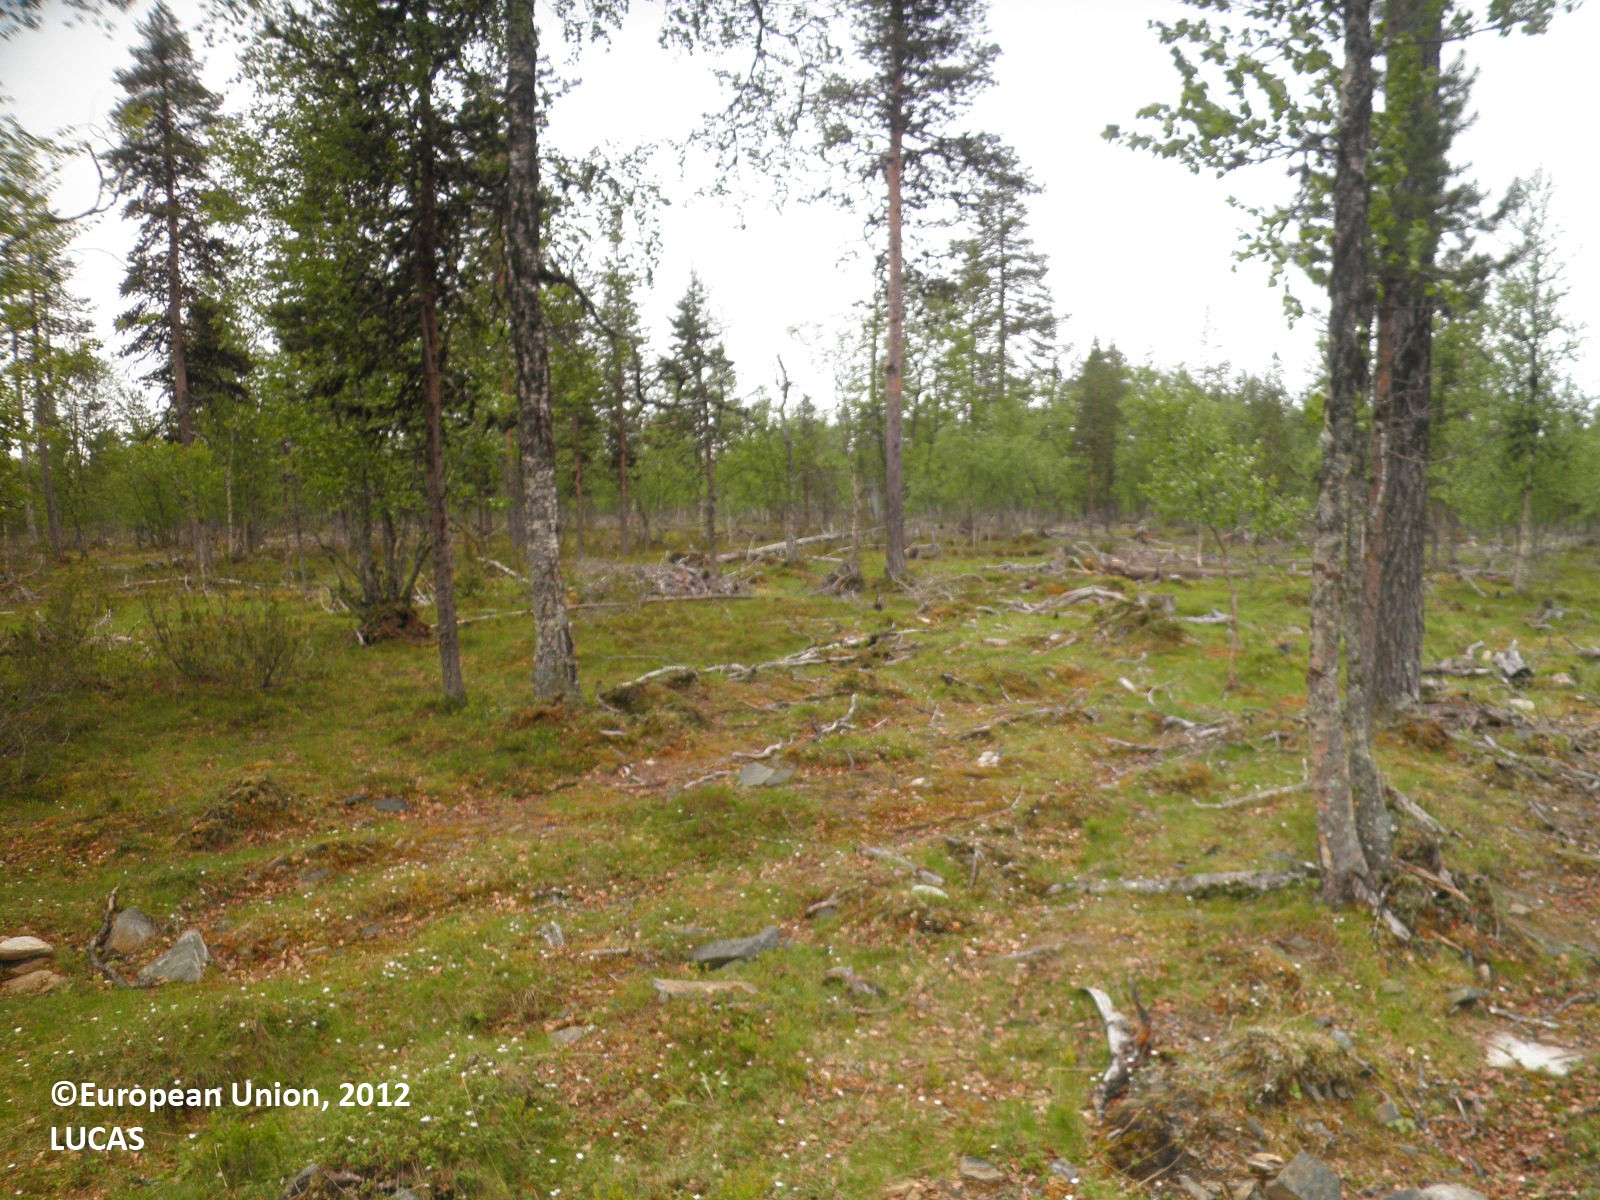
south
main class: Woodland
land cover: Pine dominated mixed woodland
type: boreal forest
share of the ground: 10 - 25 %
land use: Forestry
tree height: > 5 m
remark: Harvested field
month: July
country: FI
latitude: 68.4188
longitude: 25.8524
